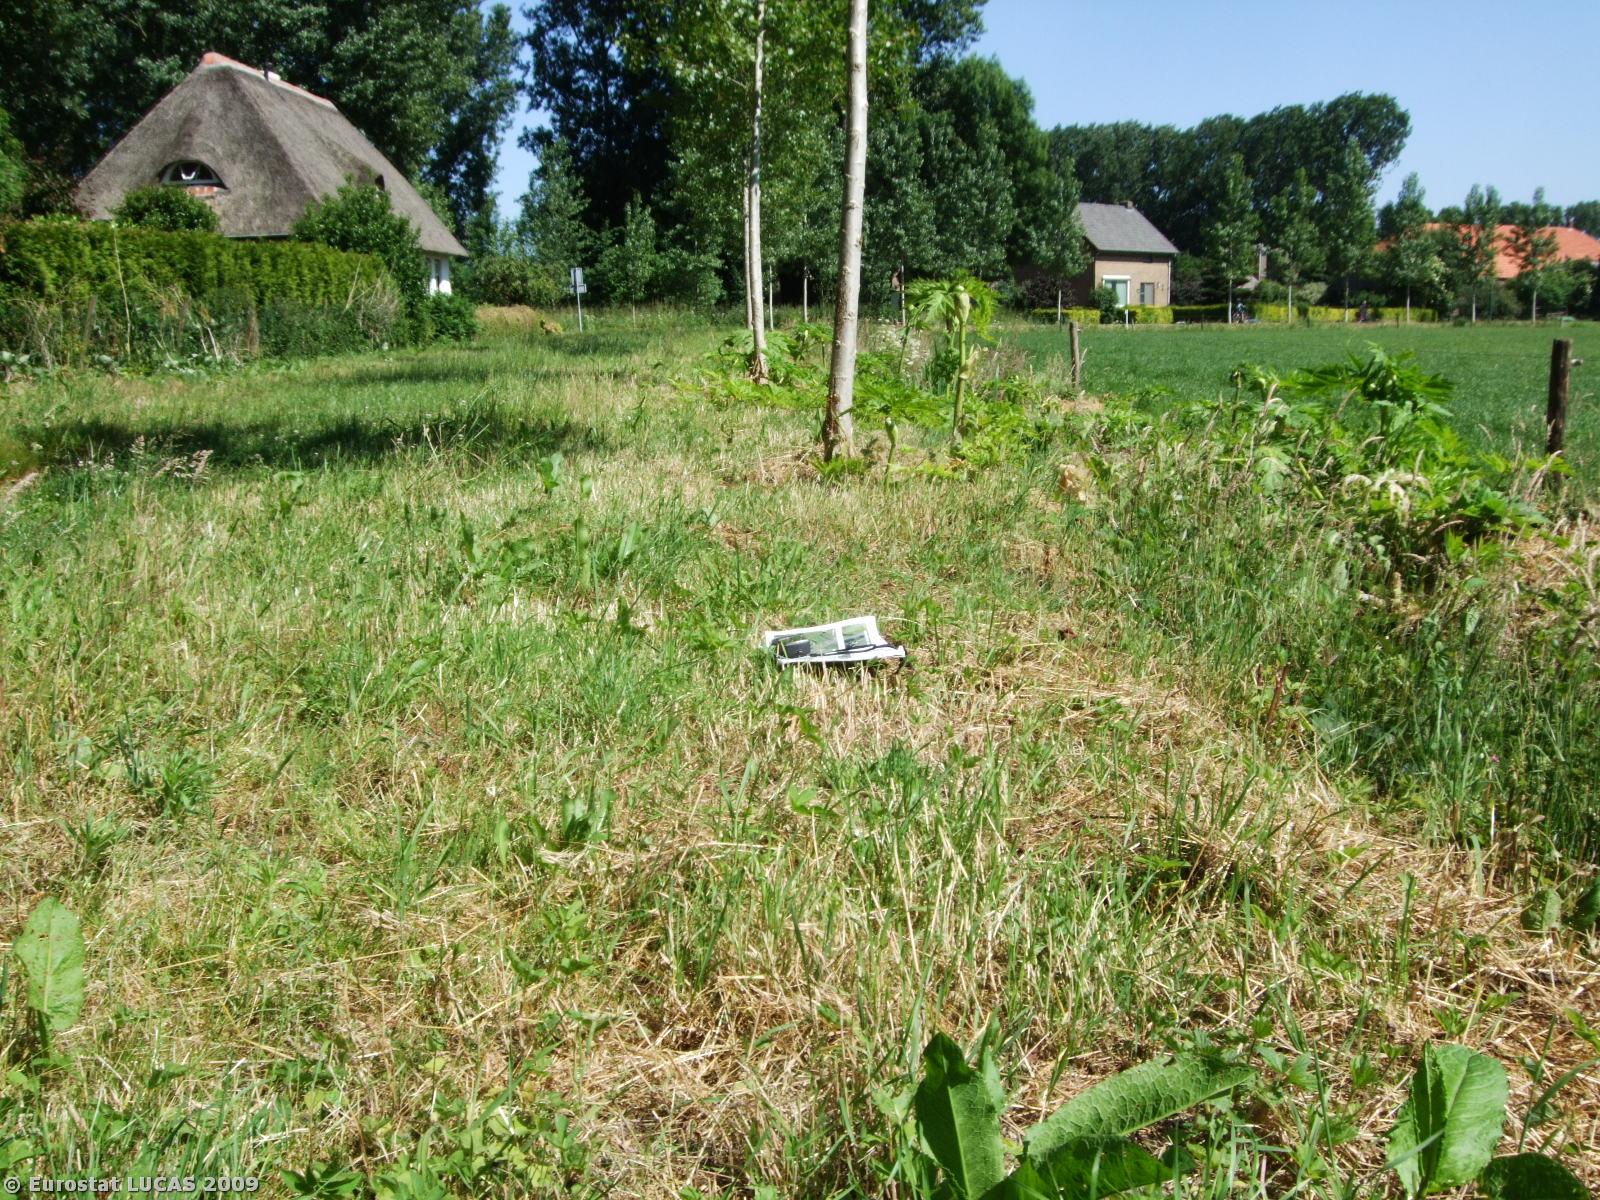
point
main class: Grassland
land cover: Grassland with sparse tree/shrub cover
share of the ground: > 75 %
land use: Road transport
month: June
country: NL
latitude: 51.5523
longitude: 5.4551
